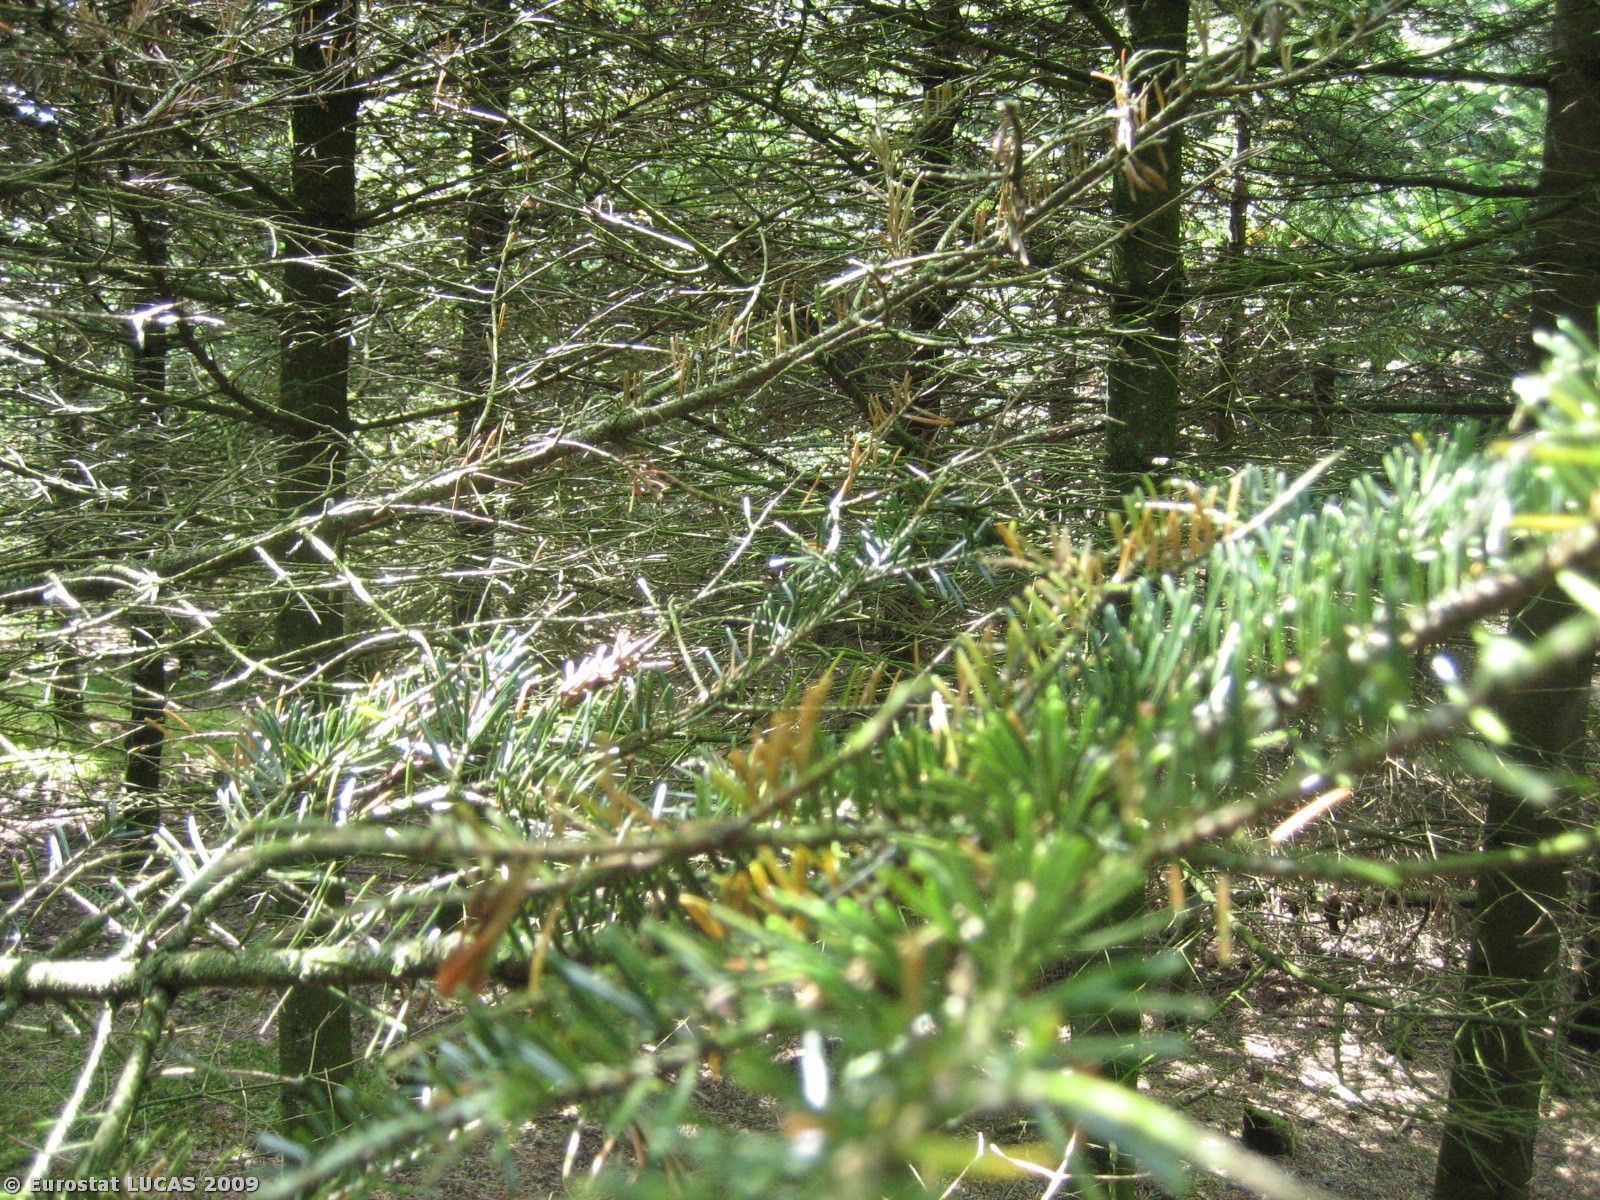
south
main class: Woodland
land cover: Coniferous woodland
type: hemiboreal forest and nemoral coniferous forest and mixed broadleaved-coniferous forest
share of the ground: > 75 %
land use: Forestry
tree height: > 5 m
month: July
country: DK
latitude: 55.6977
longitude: 8.9033
